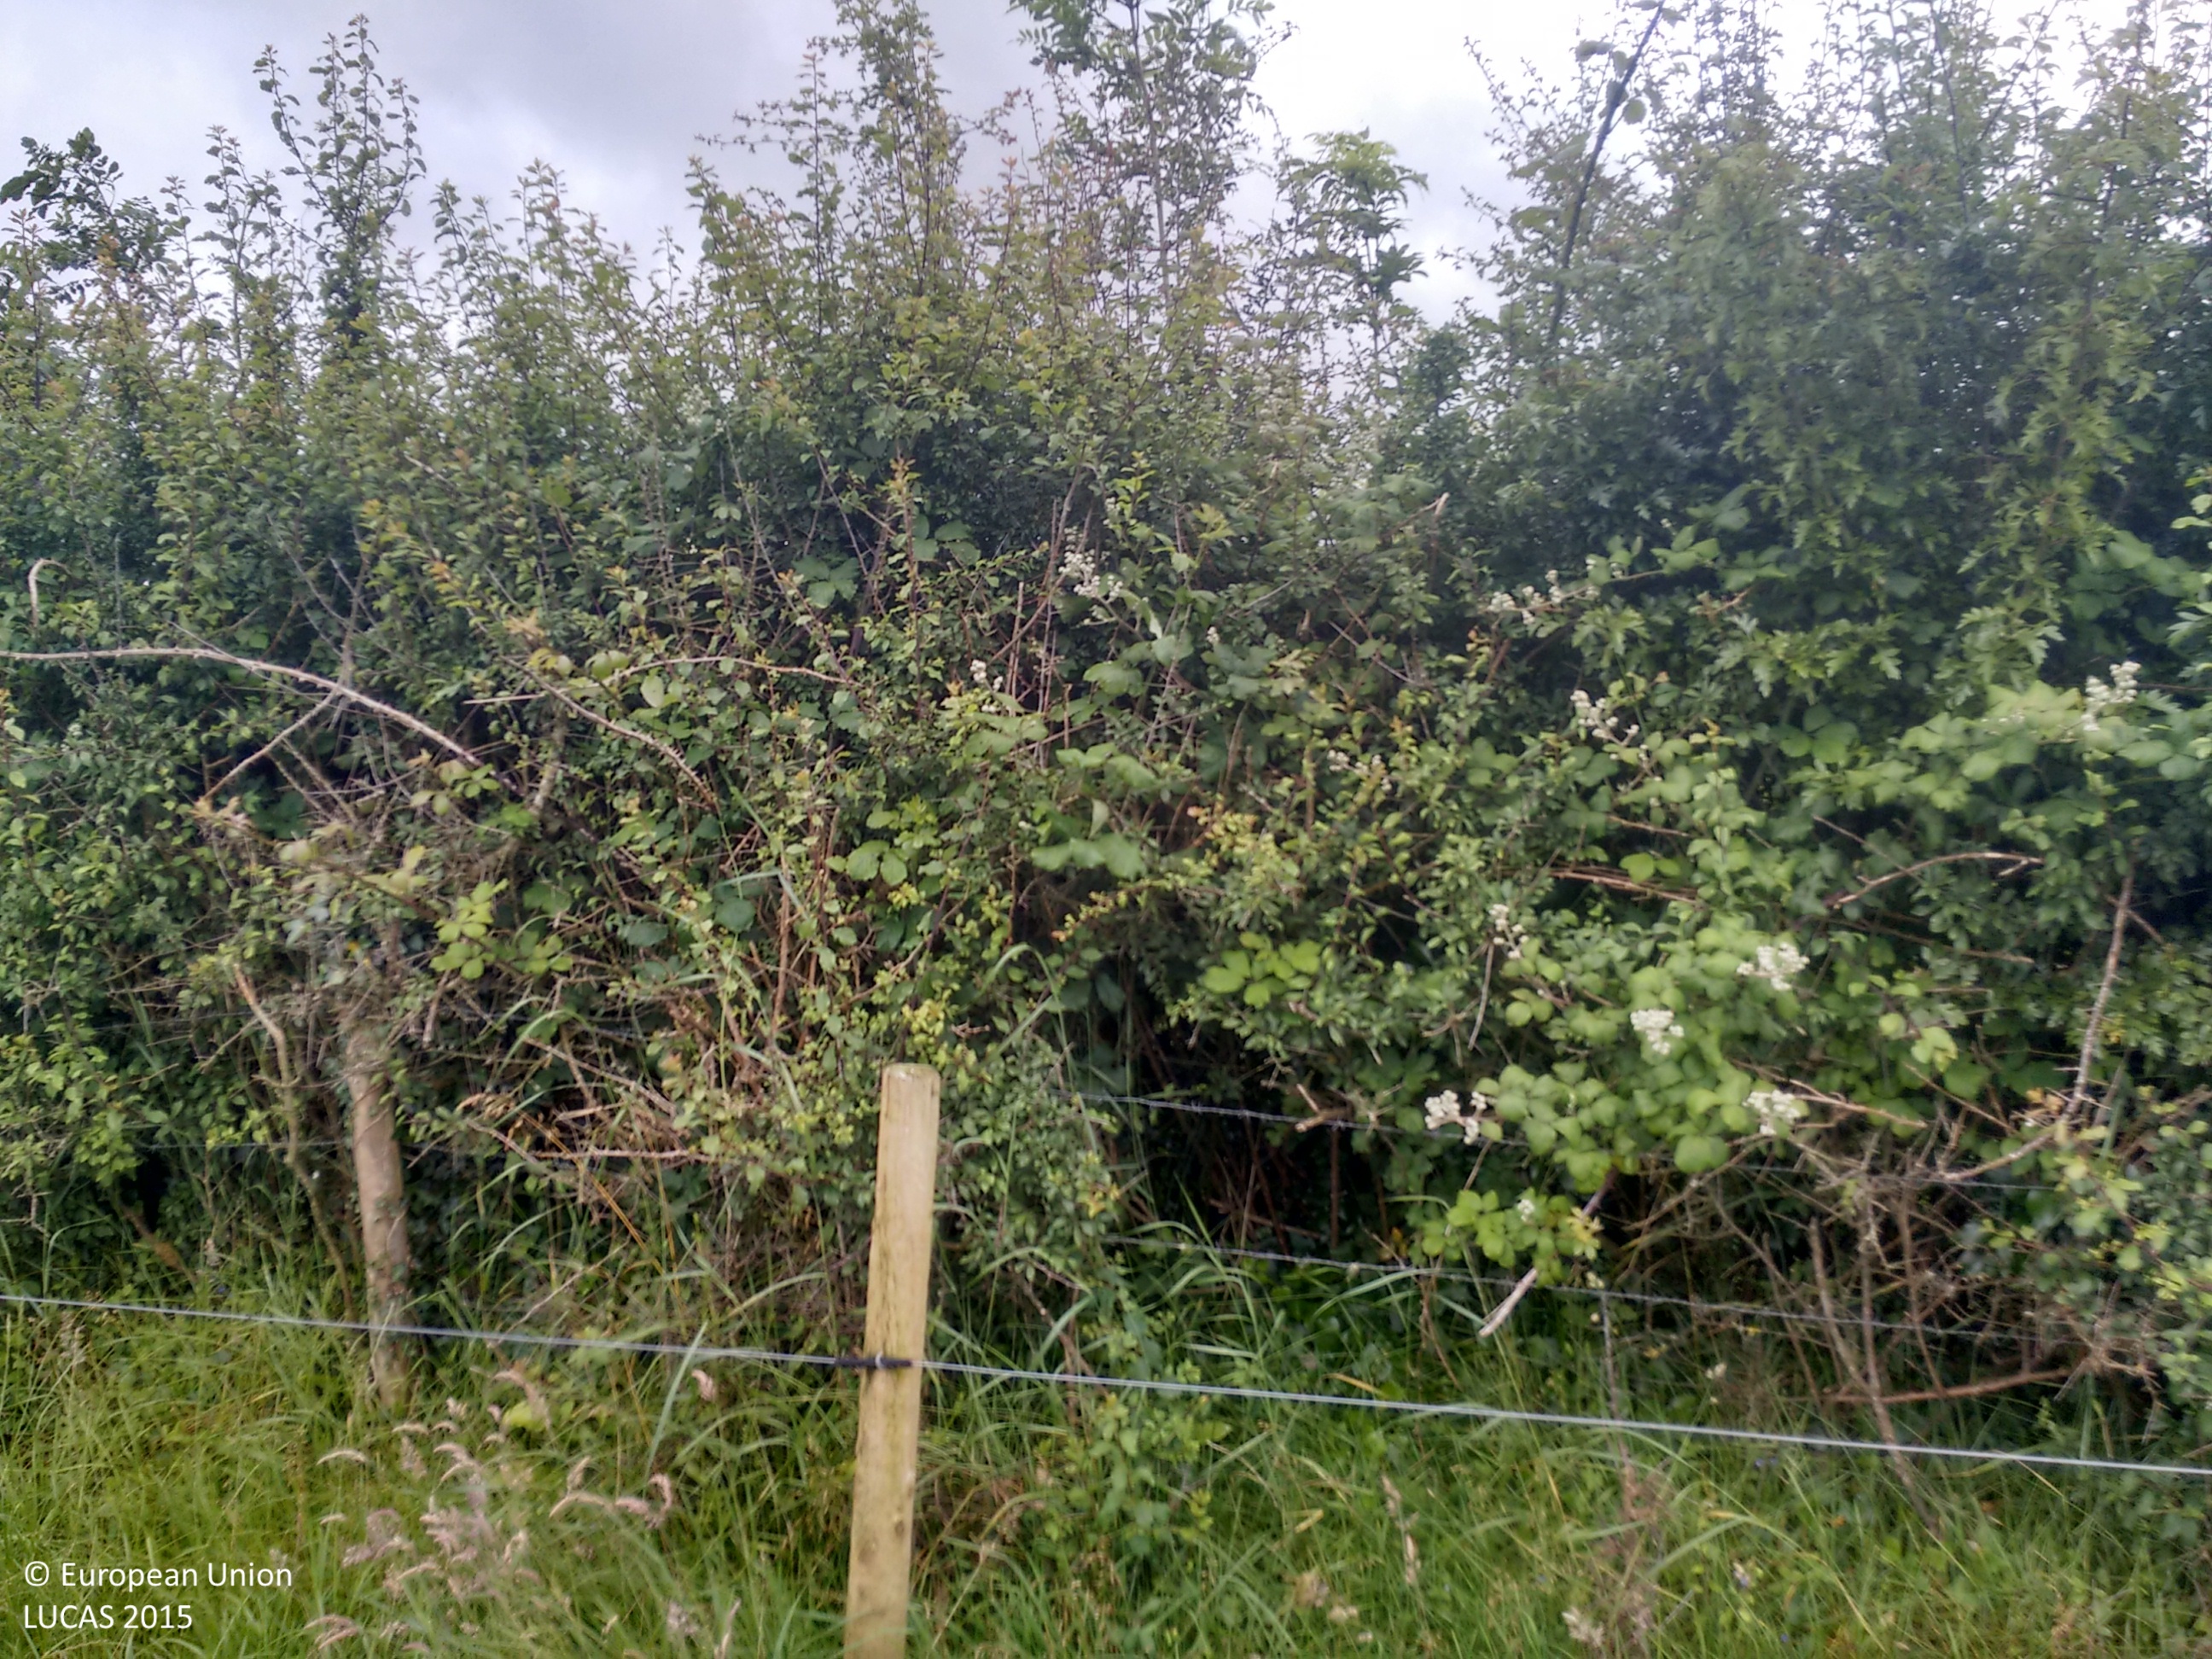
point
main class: Grassland
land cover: Grassland without tree/shrub cover
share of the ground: > 75 %
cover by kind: herbaceous plants 100 %
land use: Agriculture (excluding fallow land and kitchen gardens)
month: July
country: IE
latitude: 53.7181
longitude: -9.1759
